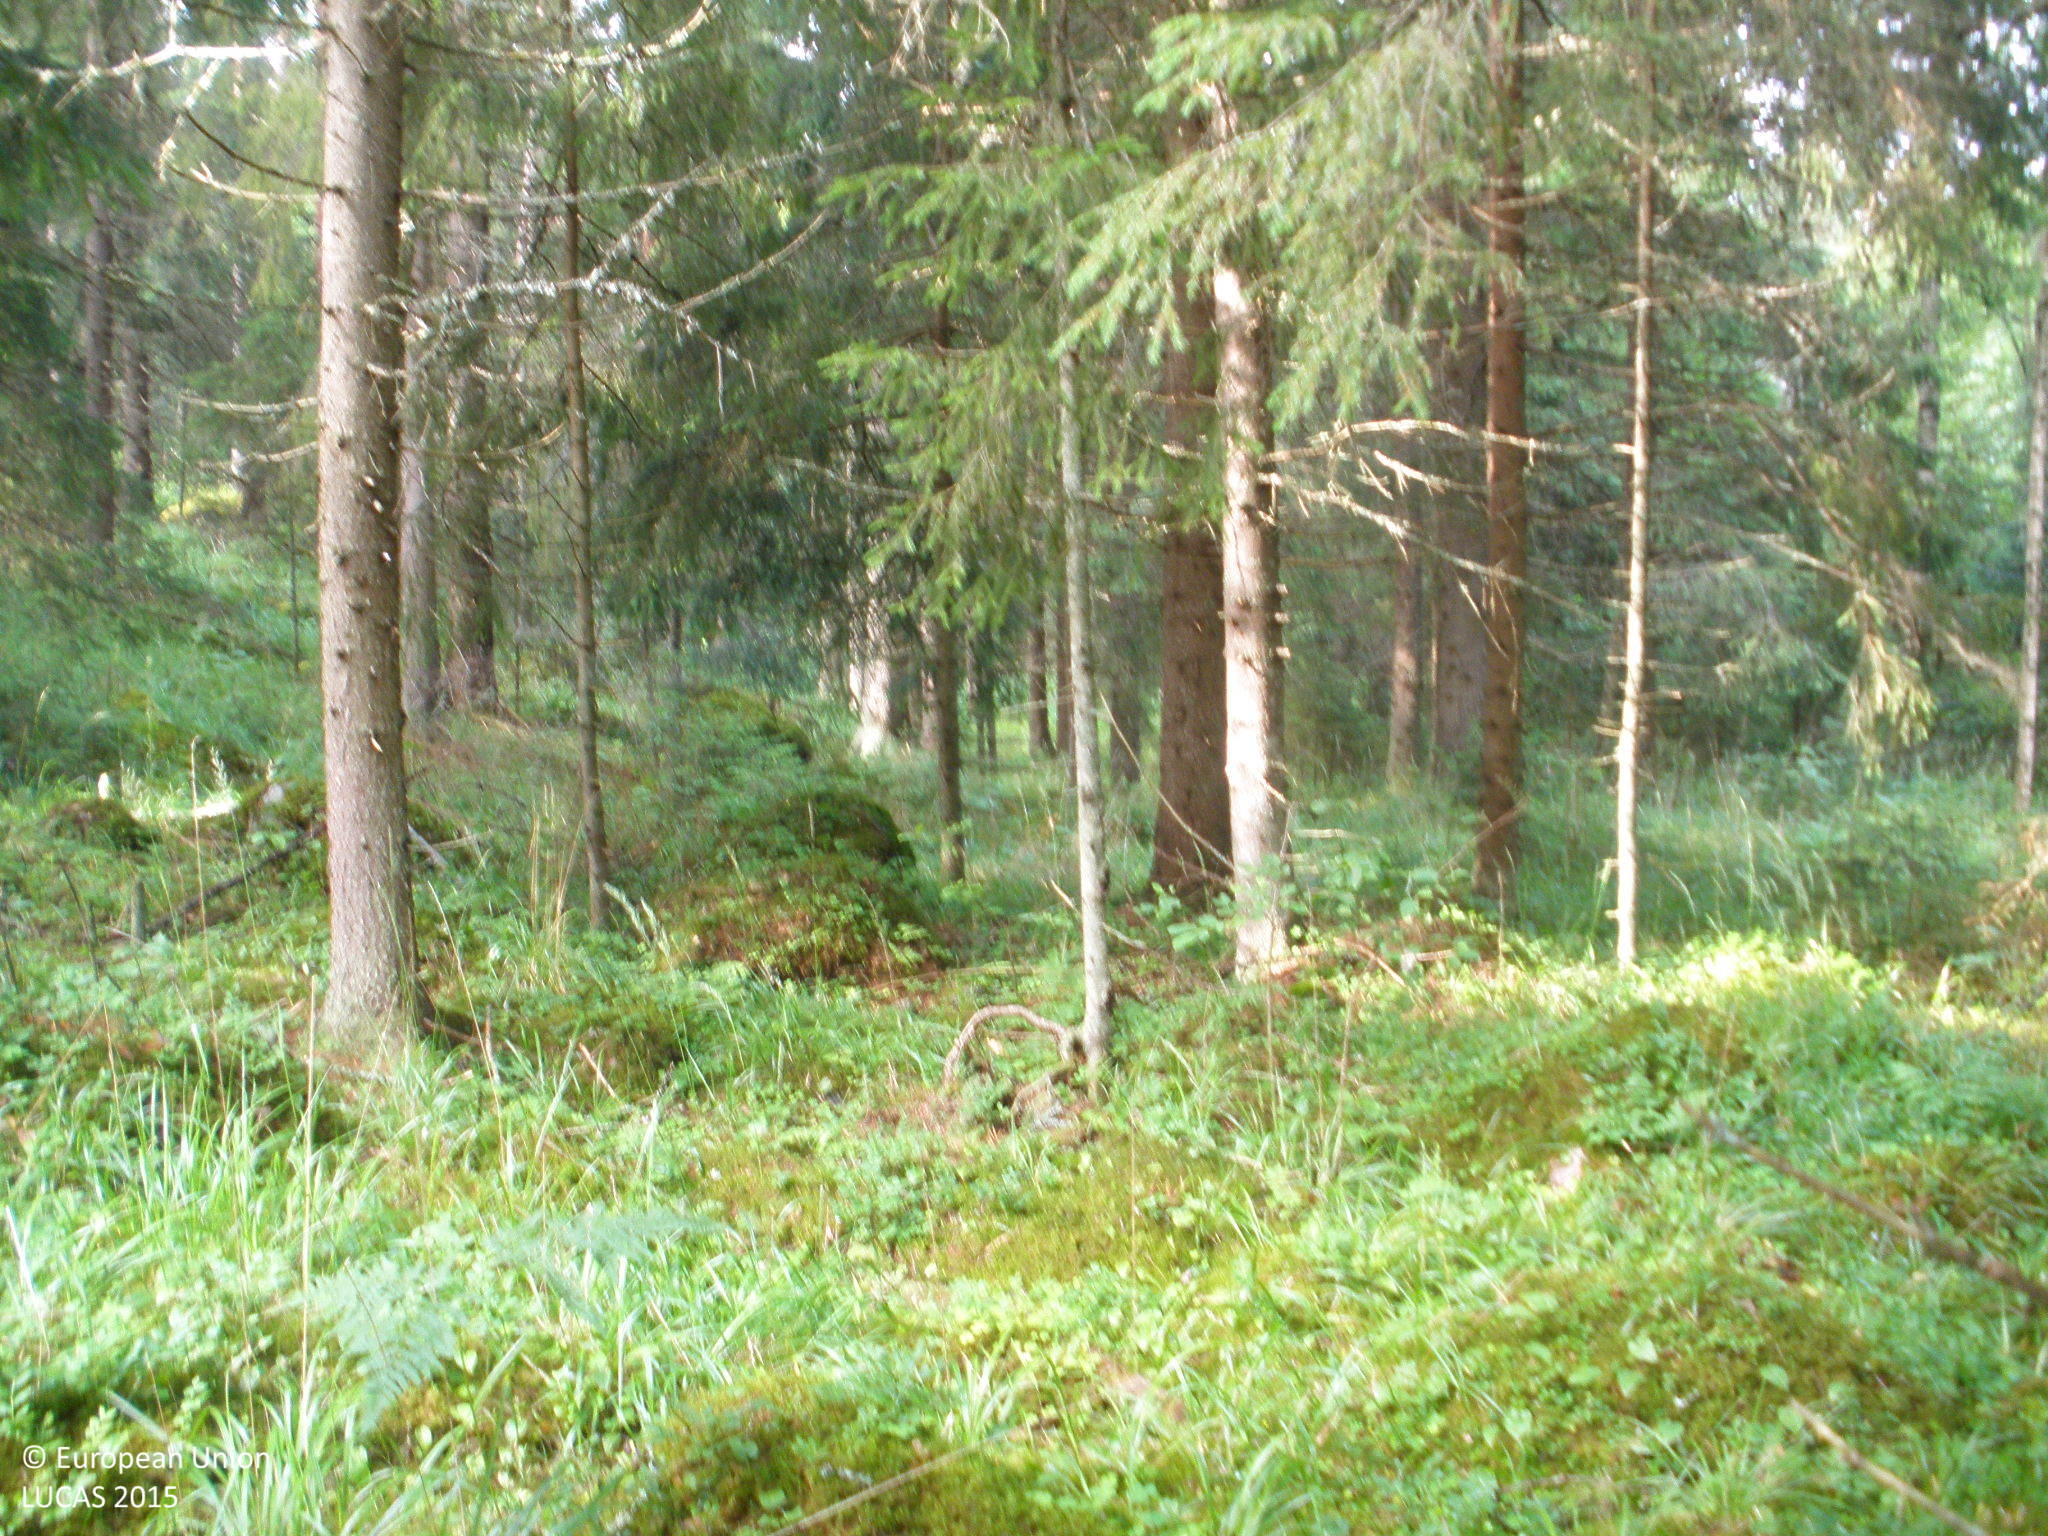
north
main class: Woodland
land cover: Spruce dominated coniferous woodland
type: boreal forest
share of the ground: > 75 %
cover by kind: coniferous forest trees 90 %, herbaceous plants 5 %, lichens and mosses 5 %
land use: Forestry
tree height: > 5 m
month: July
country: FI
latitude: 61.2558
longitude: 24.7387
